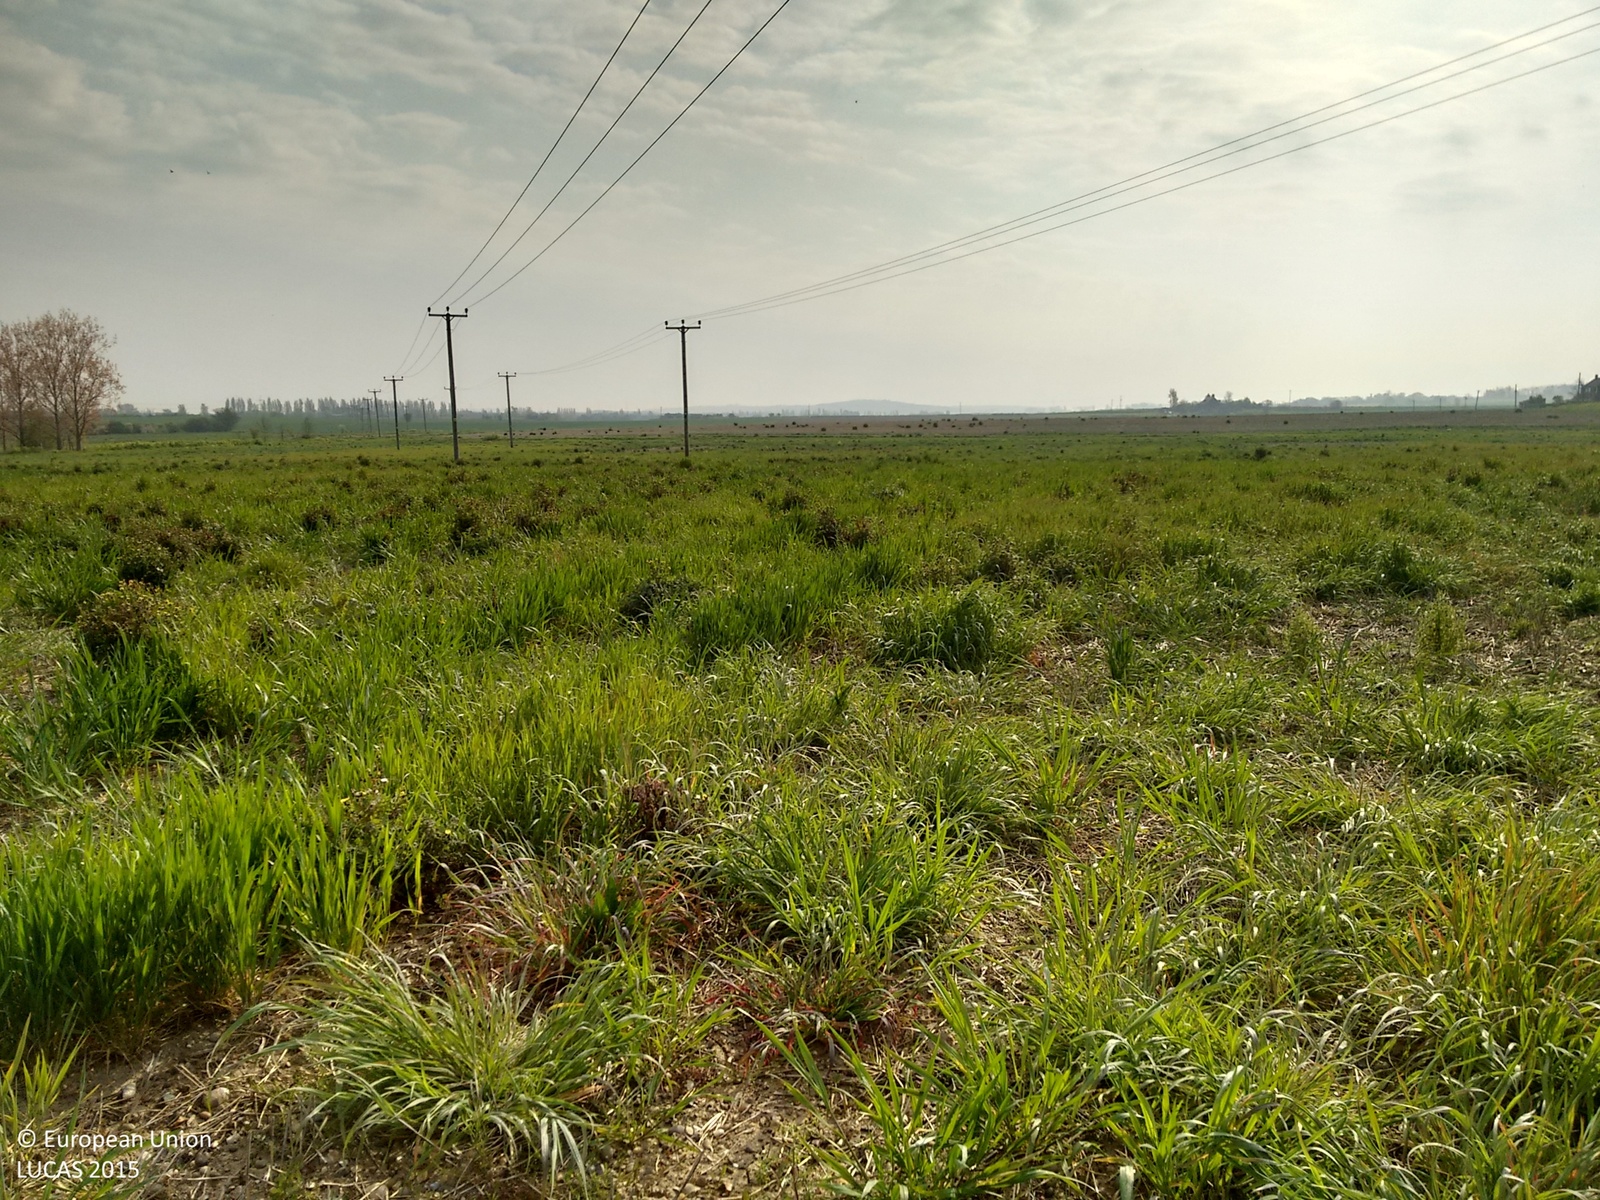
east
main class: Grassland
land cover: Spontaneously vegetated surfaces
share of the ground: 50 - 75 %
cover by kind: herbaceous plants 50 %, unconsolidated bare surface 50 %
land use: Fallow land
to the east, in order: Spontaneously vegetated surfaces; Electric lines; Spontaneously vegetated surfaces; Electric lines; Spontaneously vegetated surfaces; Tracks; Spontaneously vegetated surfaces
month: April
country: GB
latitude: 51.4292
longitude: 0.4355
